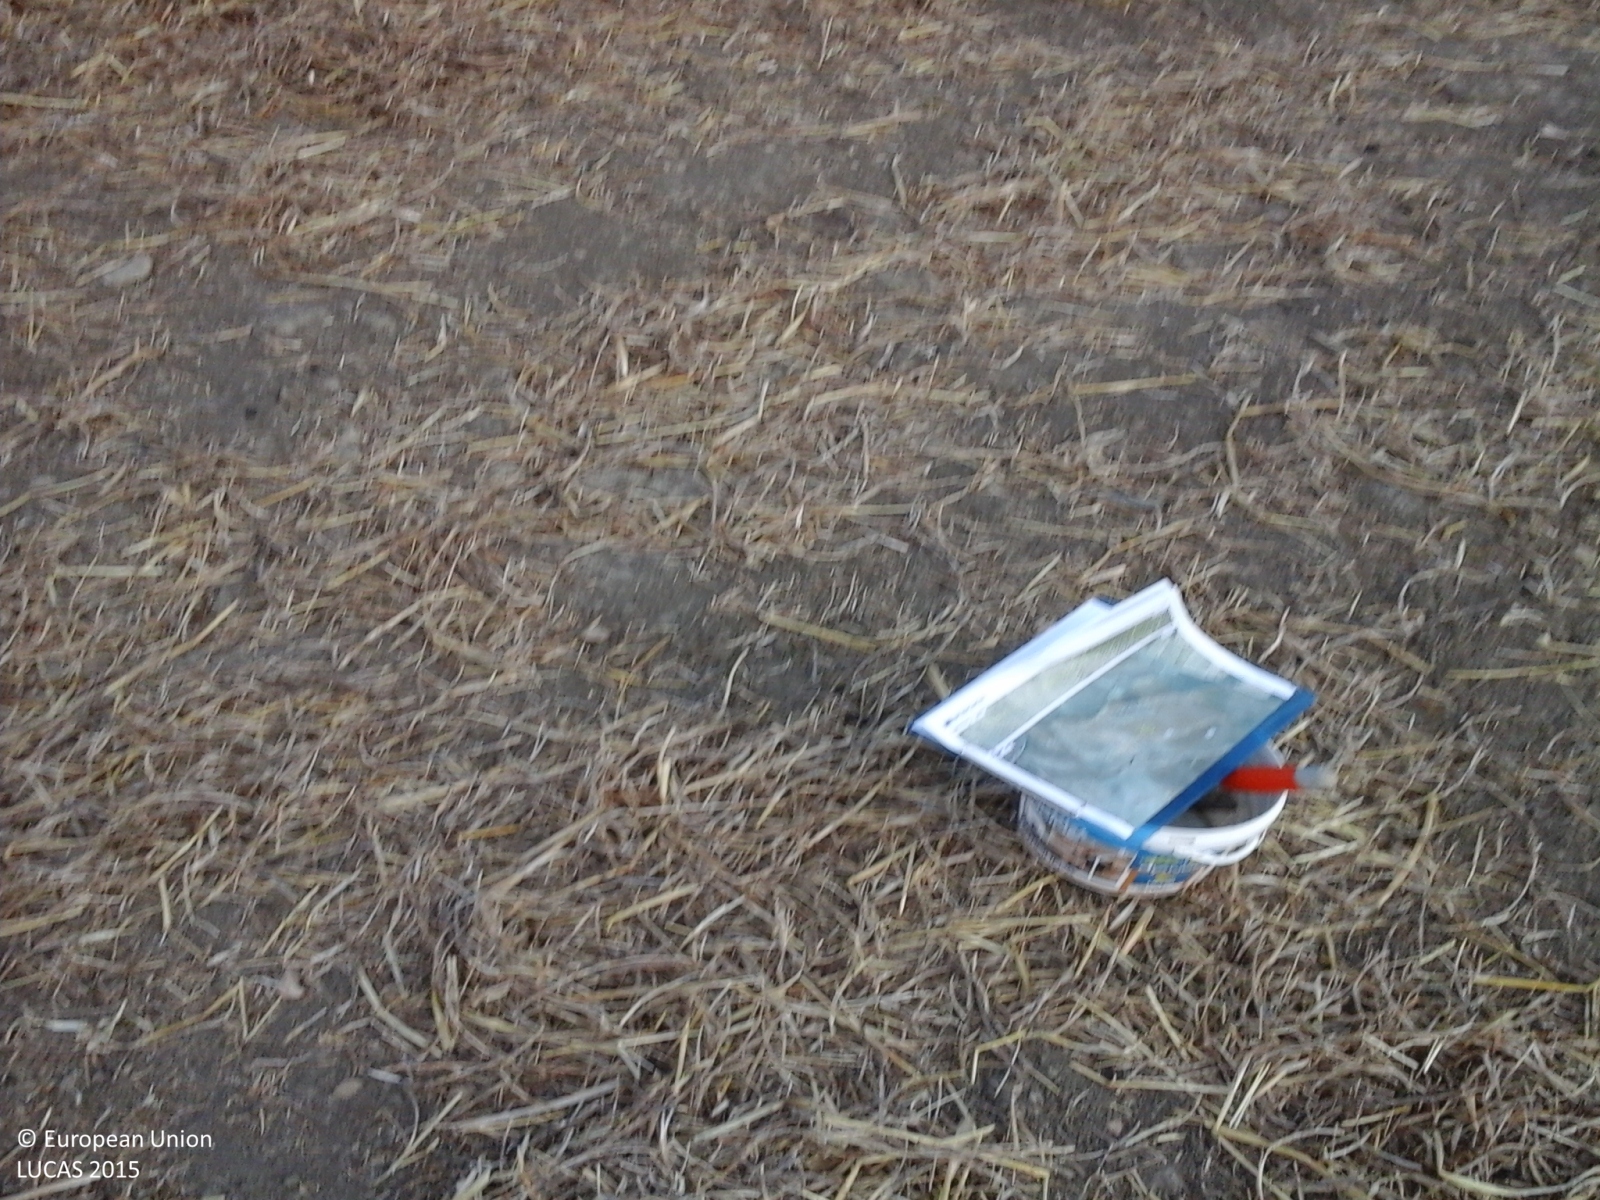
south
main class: Cropland
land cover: Temporary grasslands
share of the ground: 10 - 25 %
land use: Agriculture (excluding fallow land and kitchen gardens)
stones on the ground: < 10 %
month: July
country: IT
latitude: 37.3265
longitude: 14.2224
